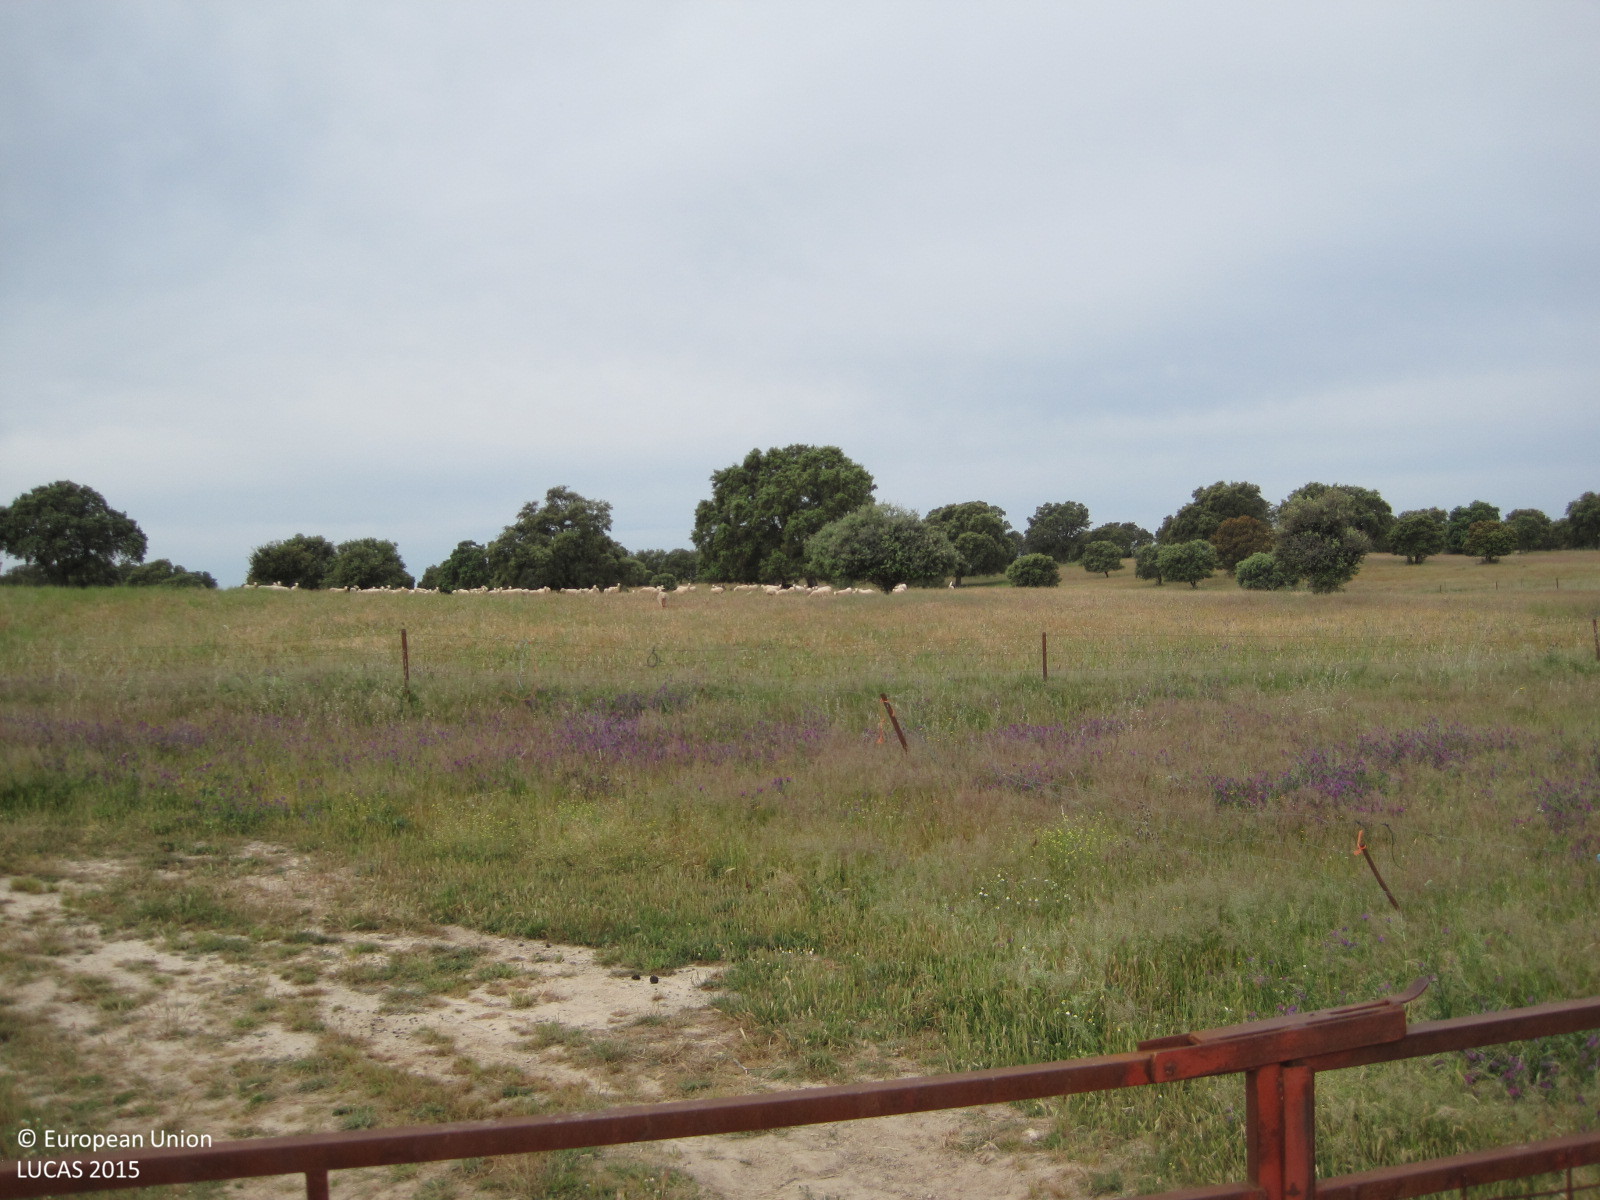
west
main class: Cropland
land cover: Arable land (only in case pi)
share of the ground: > 75 %
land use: Agriculture (excluding fallow land and kitchen gardens)
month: May
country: ES
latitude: 39.8951
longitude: -5.1270
